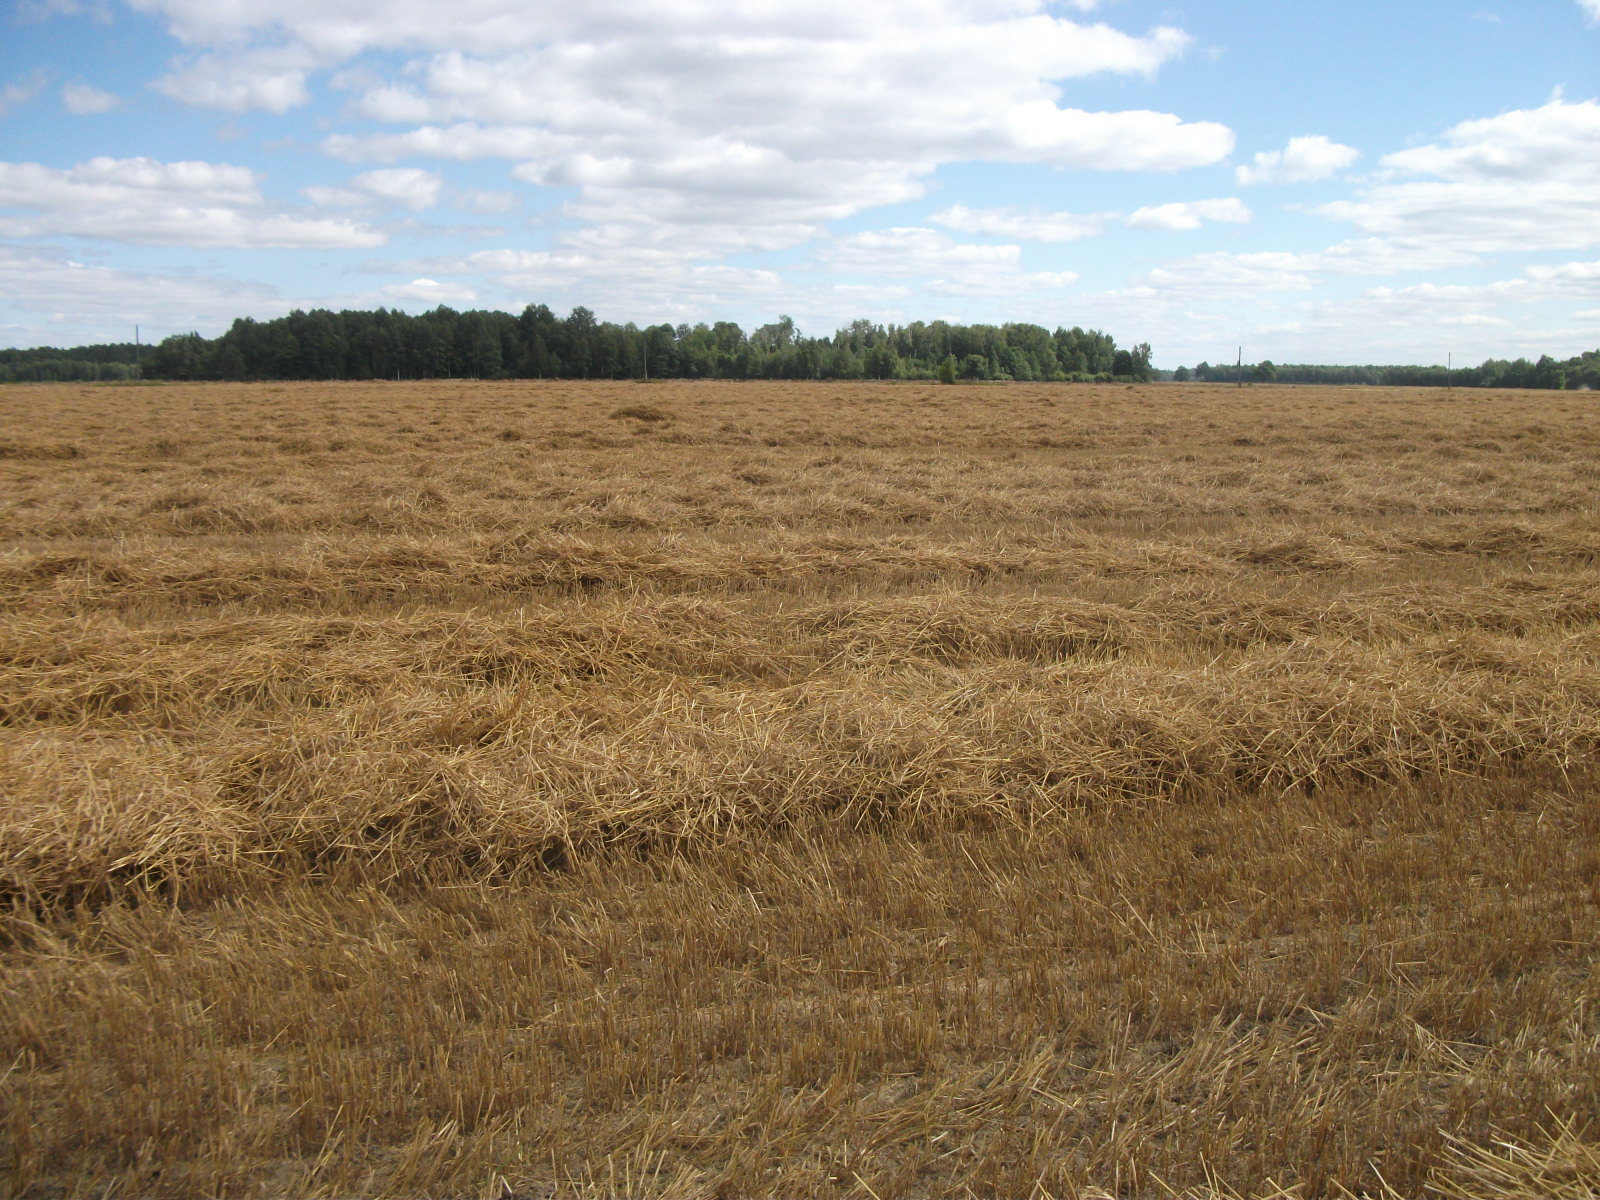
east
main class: Cropland
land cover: Barley
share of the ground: < 10 %
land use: Agriculture (excluding fallow land and kitchen gardens)
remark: Harvested field
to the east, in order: Barley
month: August
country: LV
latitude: 56.5745
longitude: 26.4057
